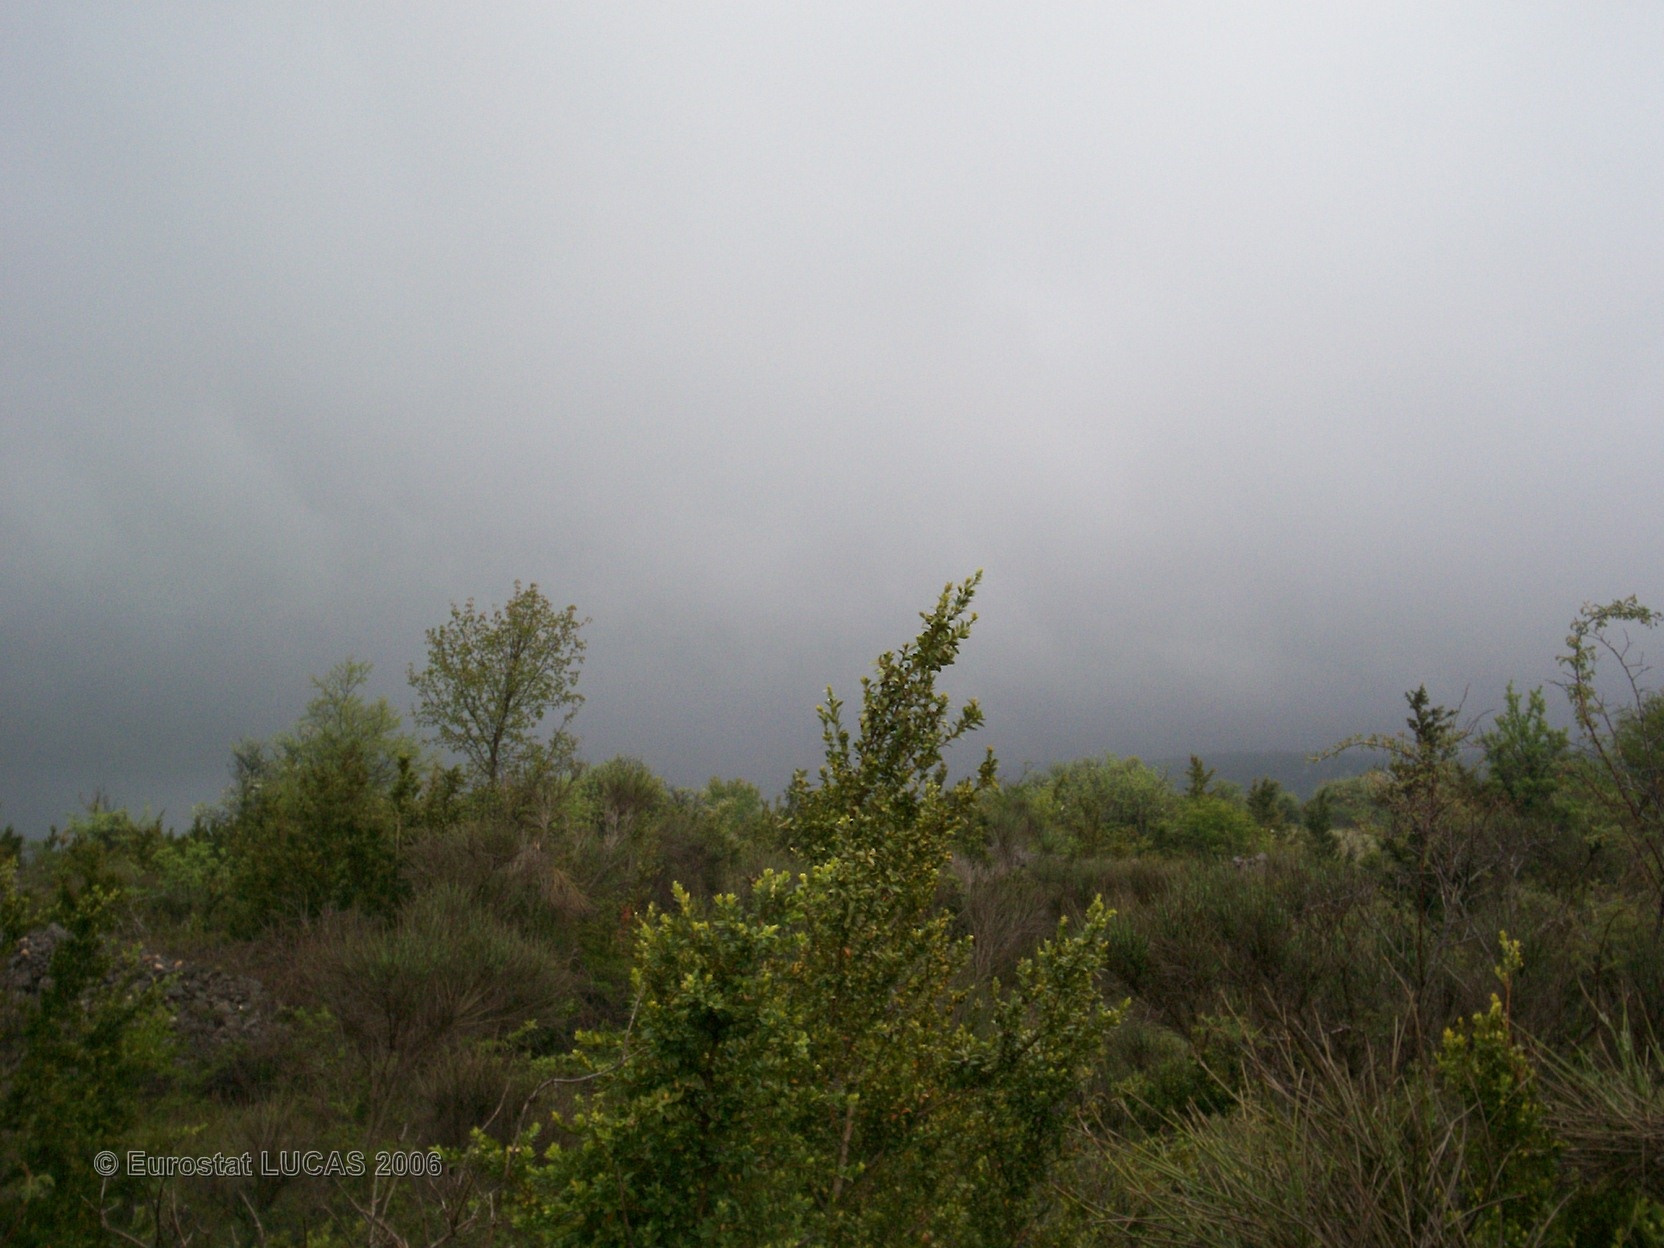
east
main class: Shrubland
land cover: Shrubland without tree cover
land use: Unused
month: May
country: FR
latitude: 43.9291
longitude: 3.4929
